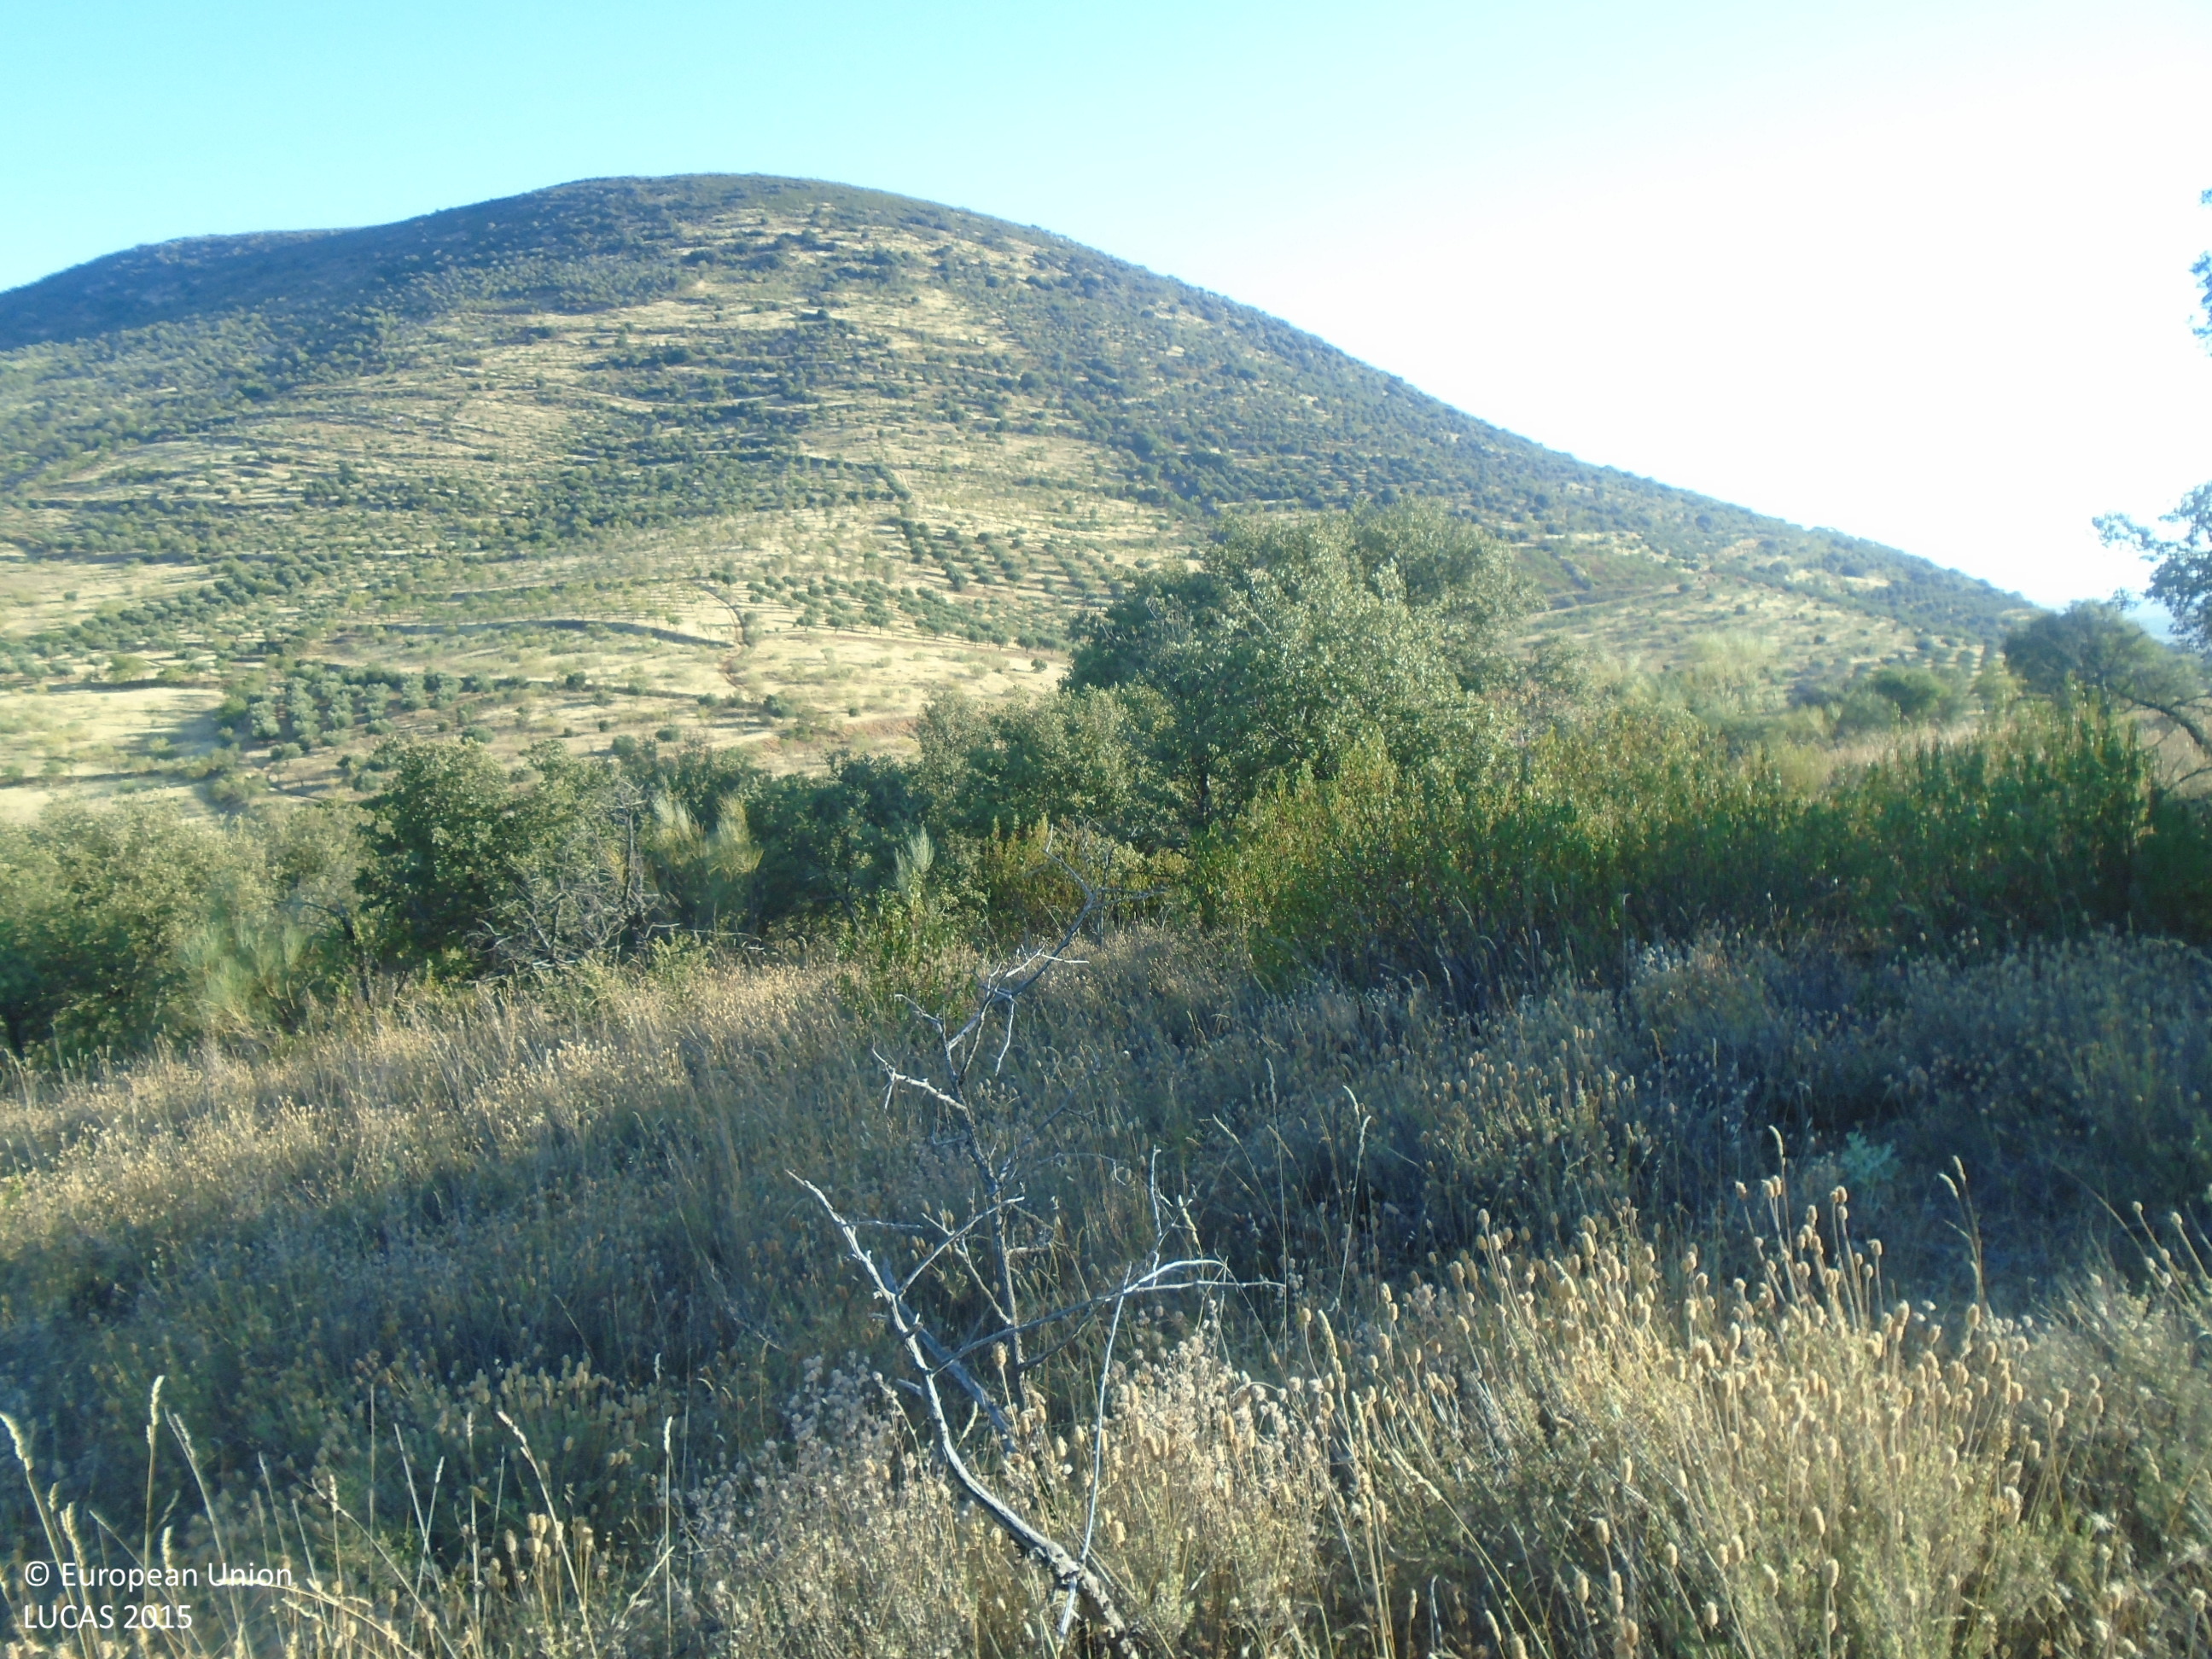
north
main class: Shrubland
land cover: Shrubland with sparse tree cover
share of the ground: > 75 %
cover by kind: shrubs 85 %, herbaceous plants 10 %, broadleaved forest trees 5 %
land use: Semi-natural and natural areas not in use
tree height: < 5 m
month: July
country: ES
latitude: 39.7003
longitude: -5.0809
